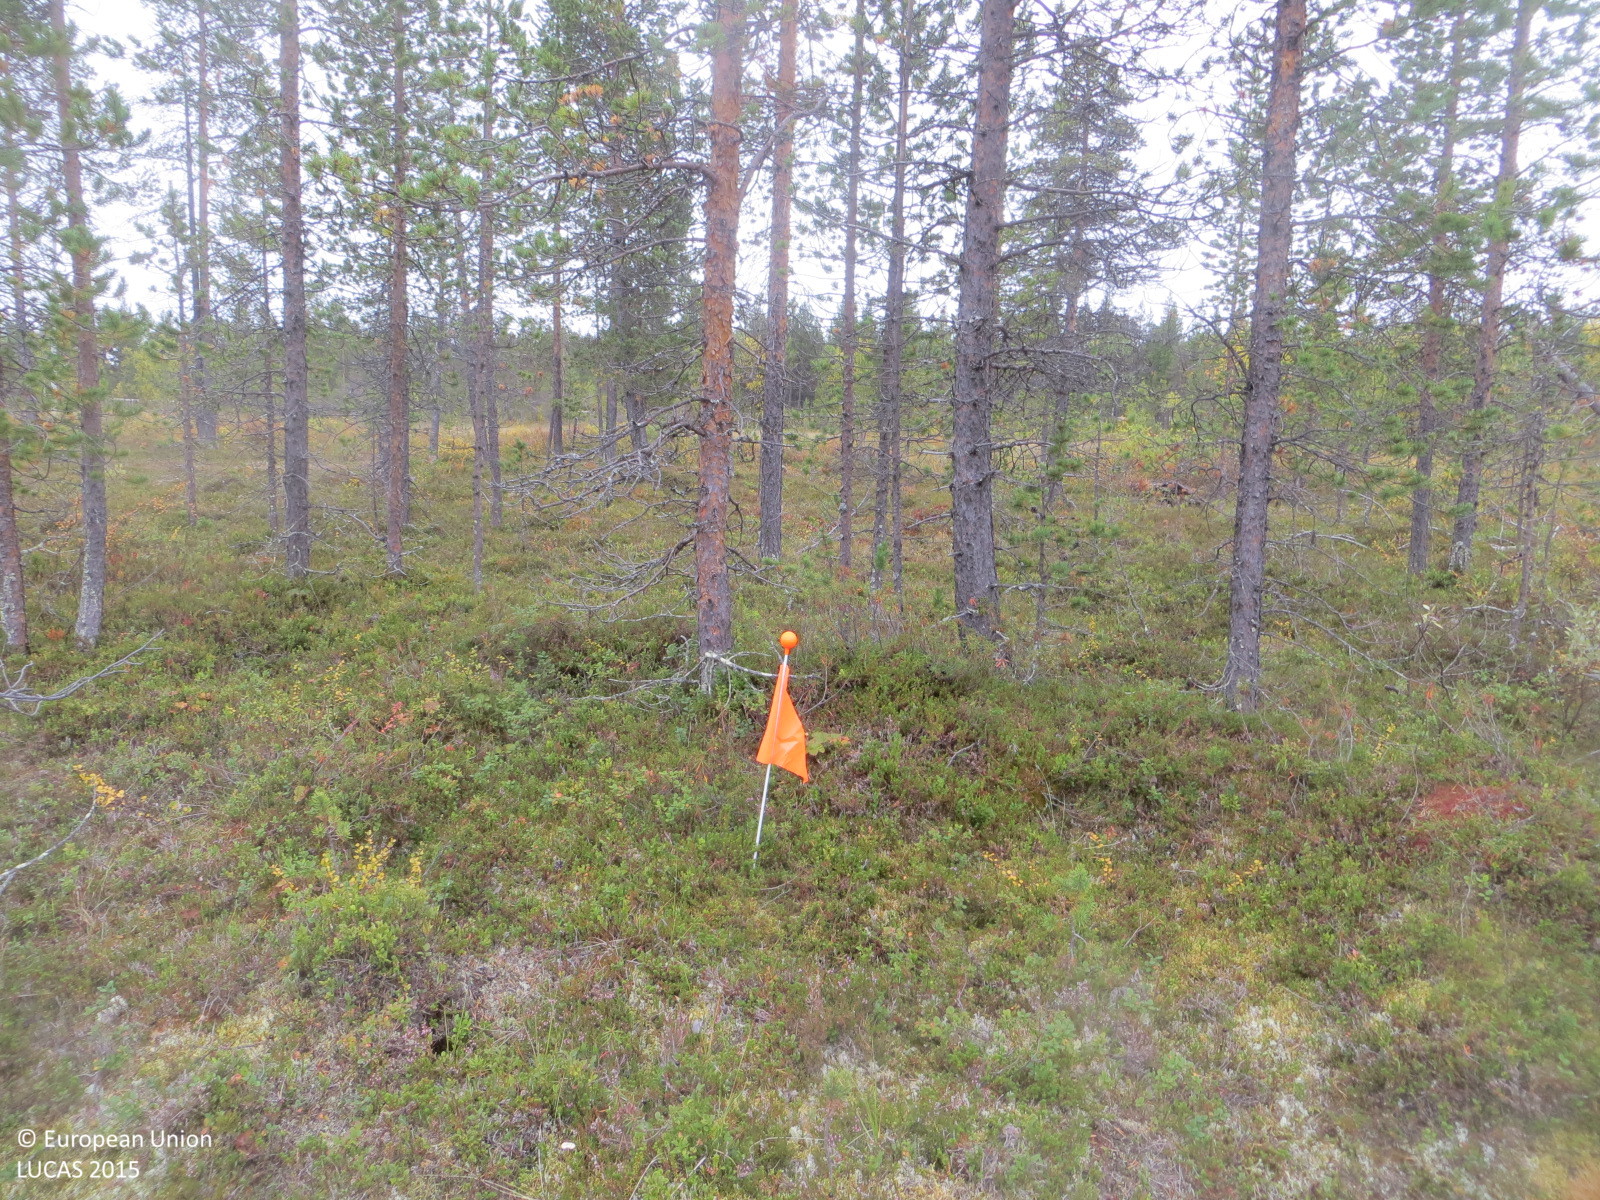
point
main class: Woodland
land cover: Pine dominated coniferous woodland
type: mire and swamp forests
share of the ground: 50 - 75 %
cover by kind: coniferous forest trees 55 %, shrubs 45 %
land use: Forestry
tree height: > 5 m
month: September
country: FI
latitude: 68.3366
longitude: 22.9360
